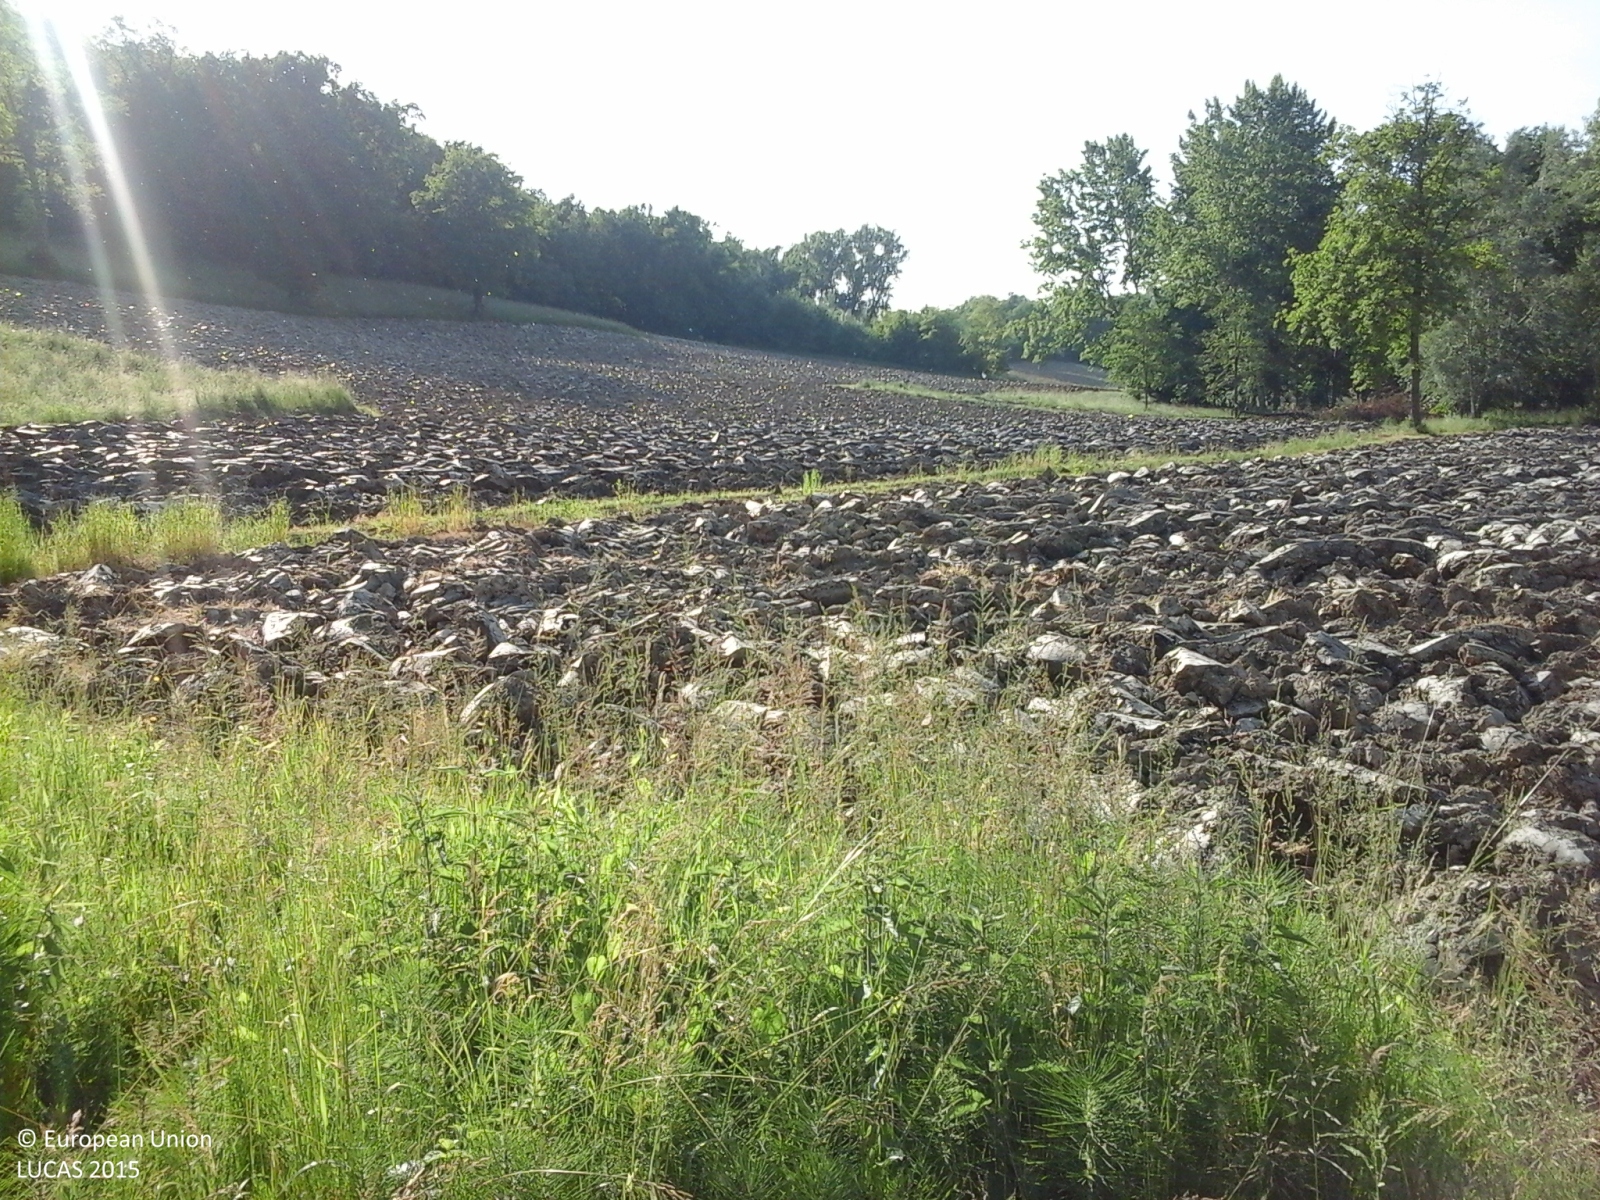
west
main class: Grassland
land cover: Spontaneously vegetated surfaces
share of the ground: > 75 %
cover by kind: herbaceous plants 100 %
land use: Agriculture (excluding fallow land and kitchen gardens)
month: May
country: IT
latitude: 45.0188
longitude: 8.1127
